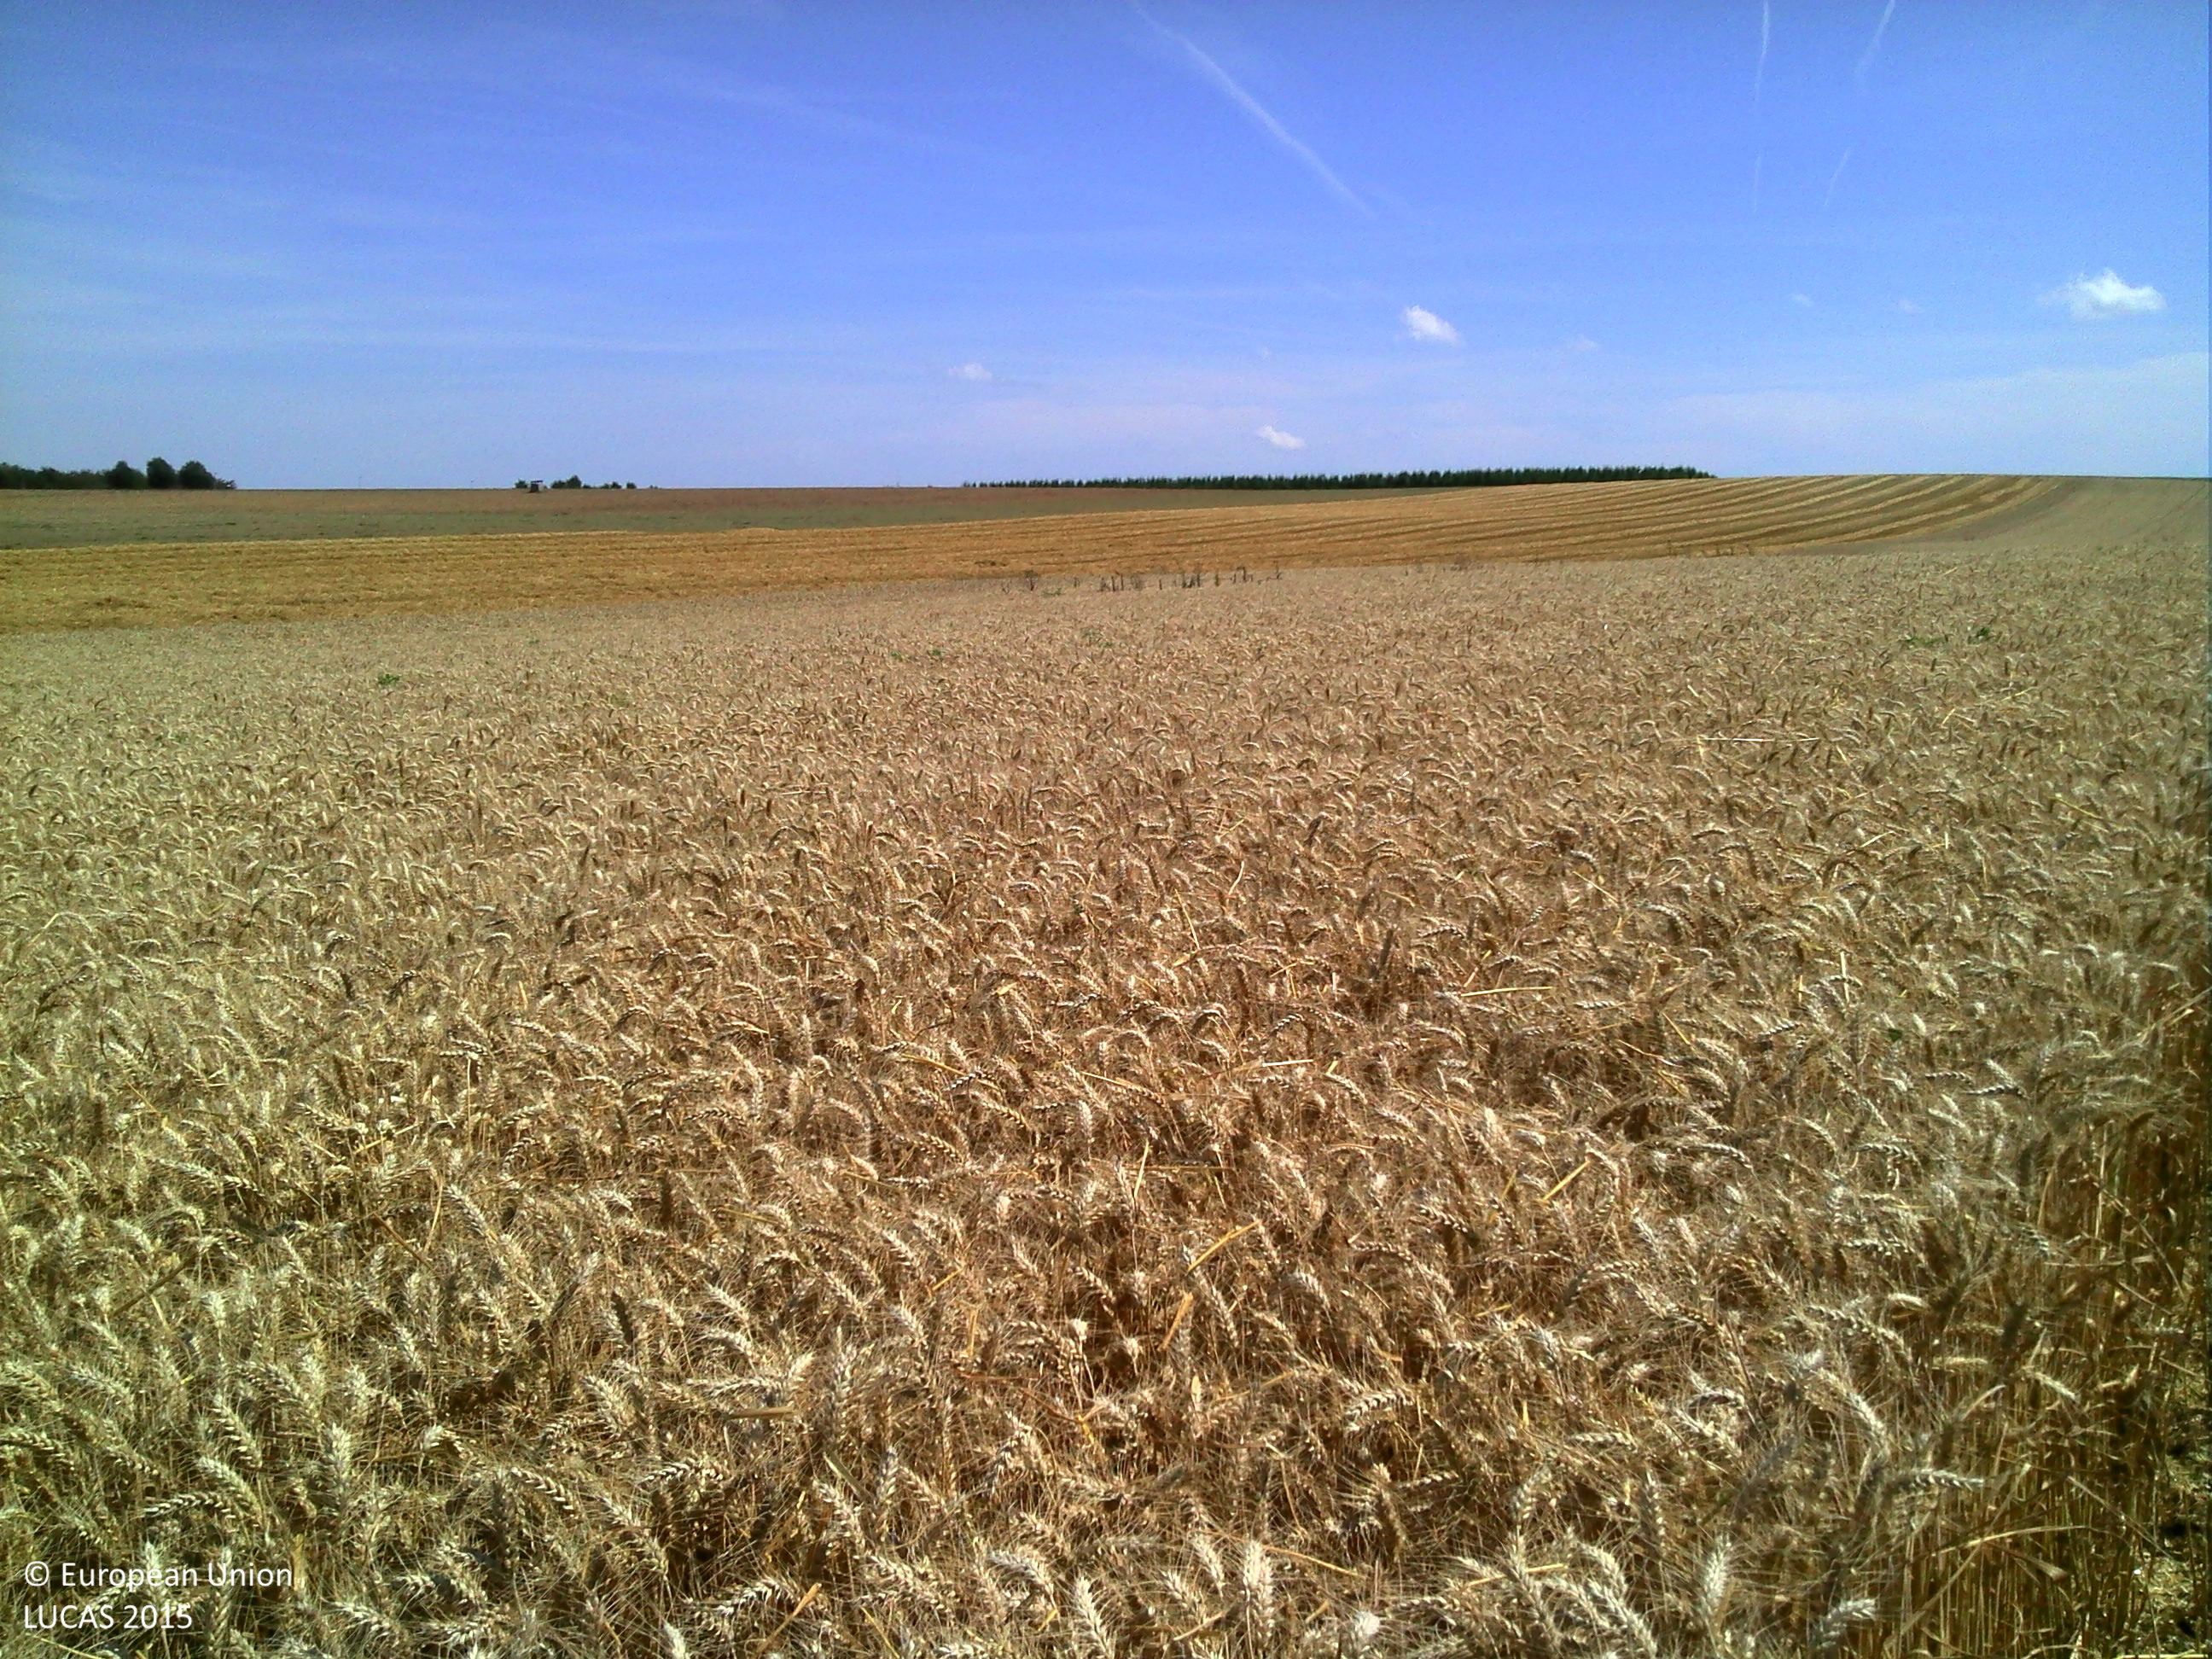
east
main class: Cropland
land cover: Common wheat
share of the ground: > 75 %
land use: Agriculture (excluding fallow land and kitchen gardens)
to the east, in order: Common wheat; Sunflower
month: August
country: BE
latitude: 50.7350
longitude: 5.2795
